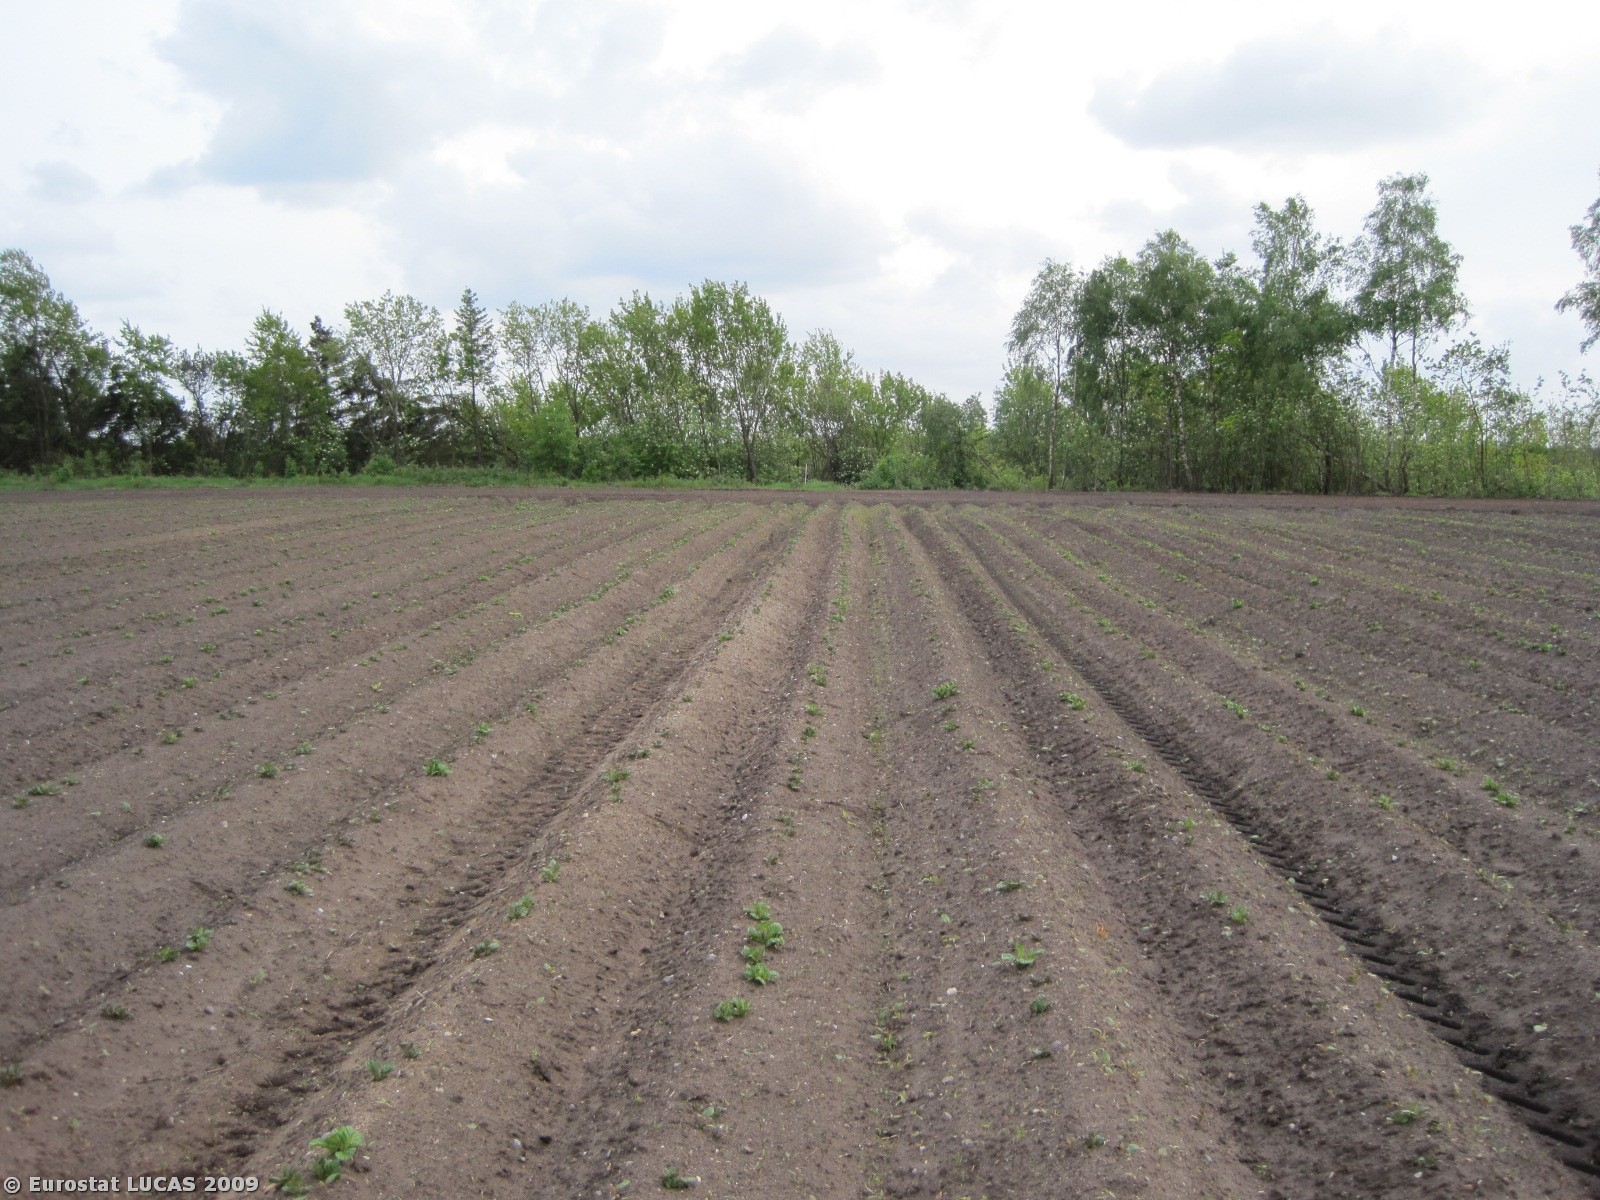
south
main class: Cropland
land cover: Potatoes
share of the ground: < 10 %
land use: Agriculture (excluding fallow land and kitchen gardens)
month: May
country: DK
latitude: 56.3830
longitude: 9.2074
